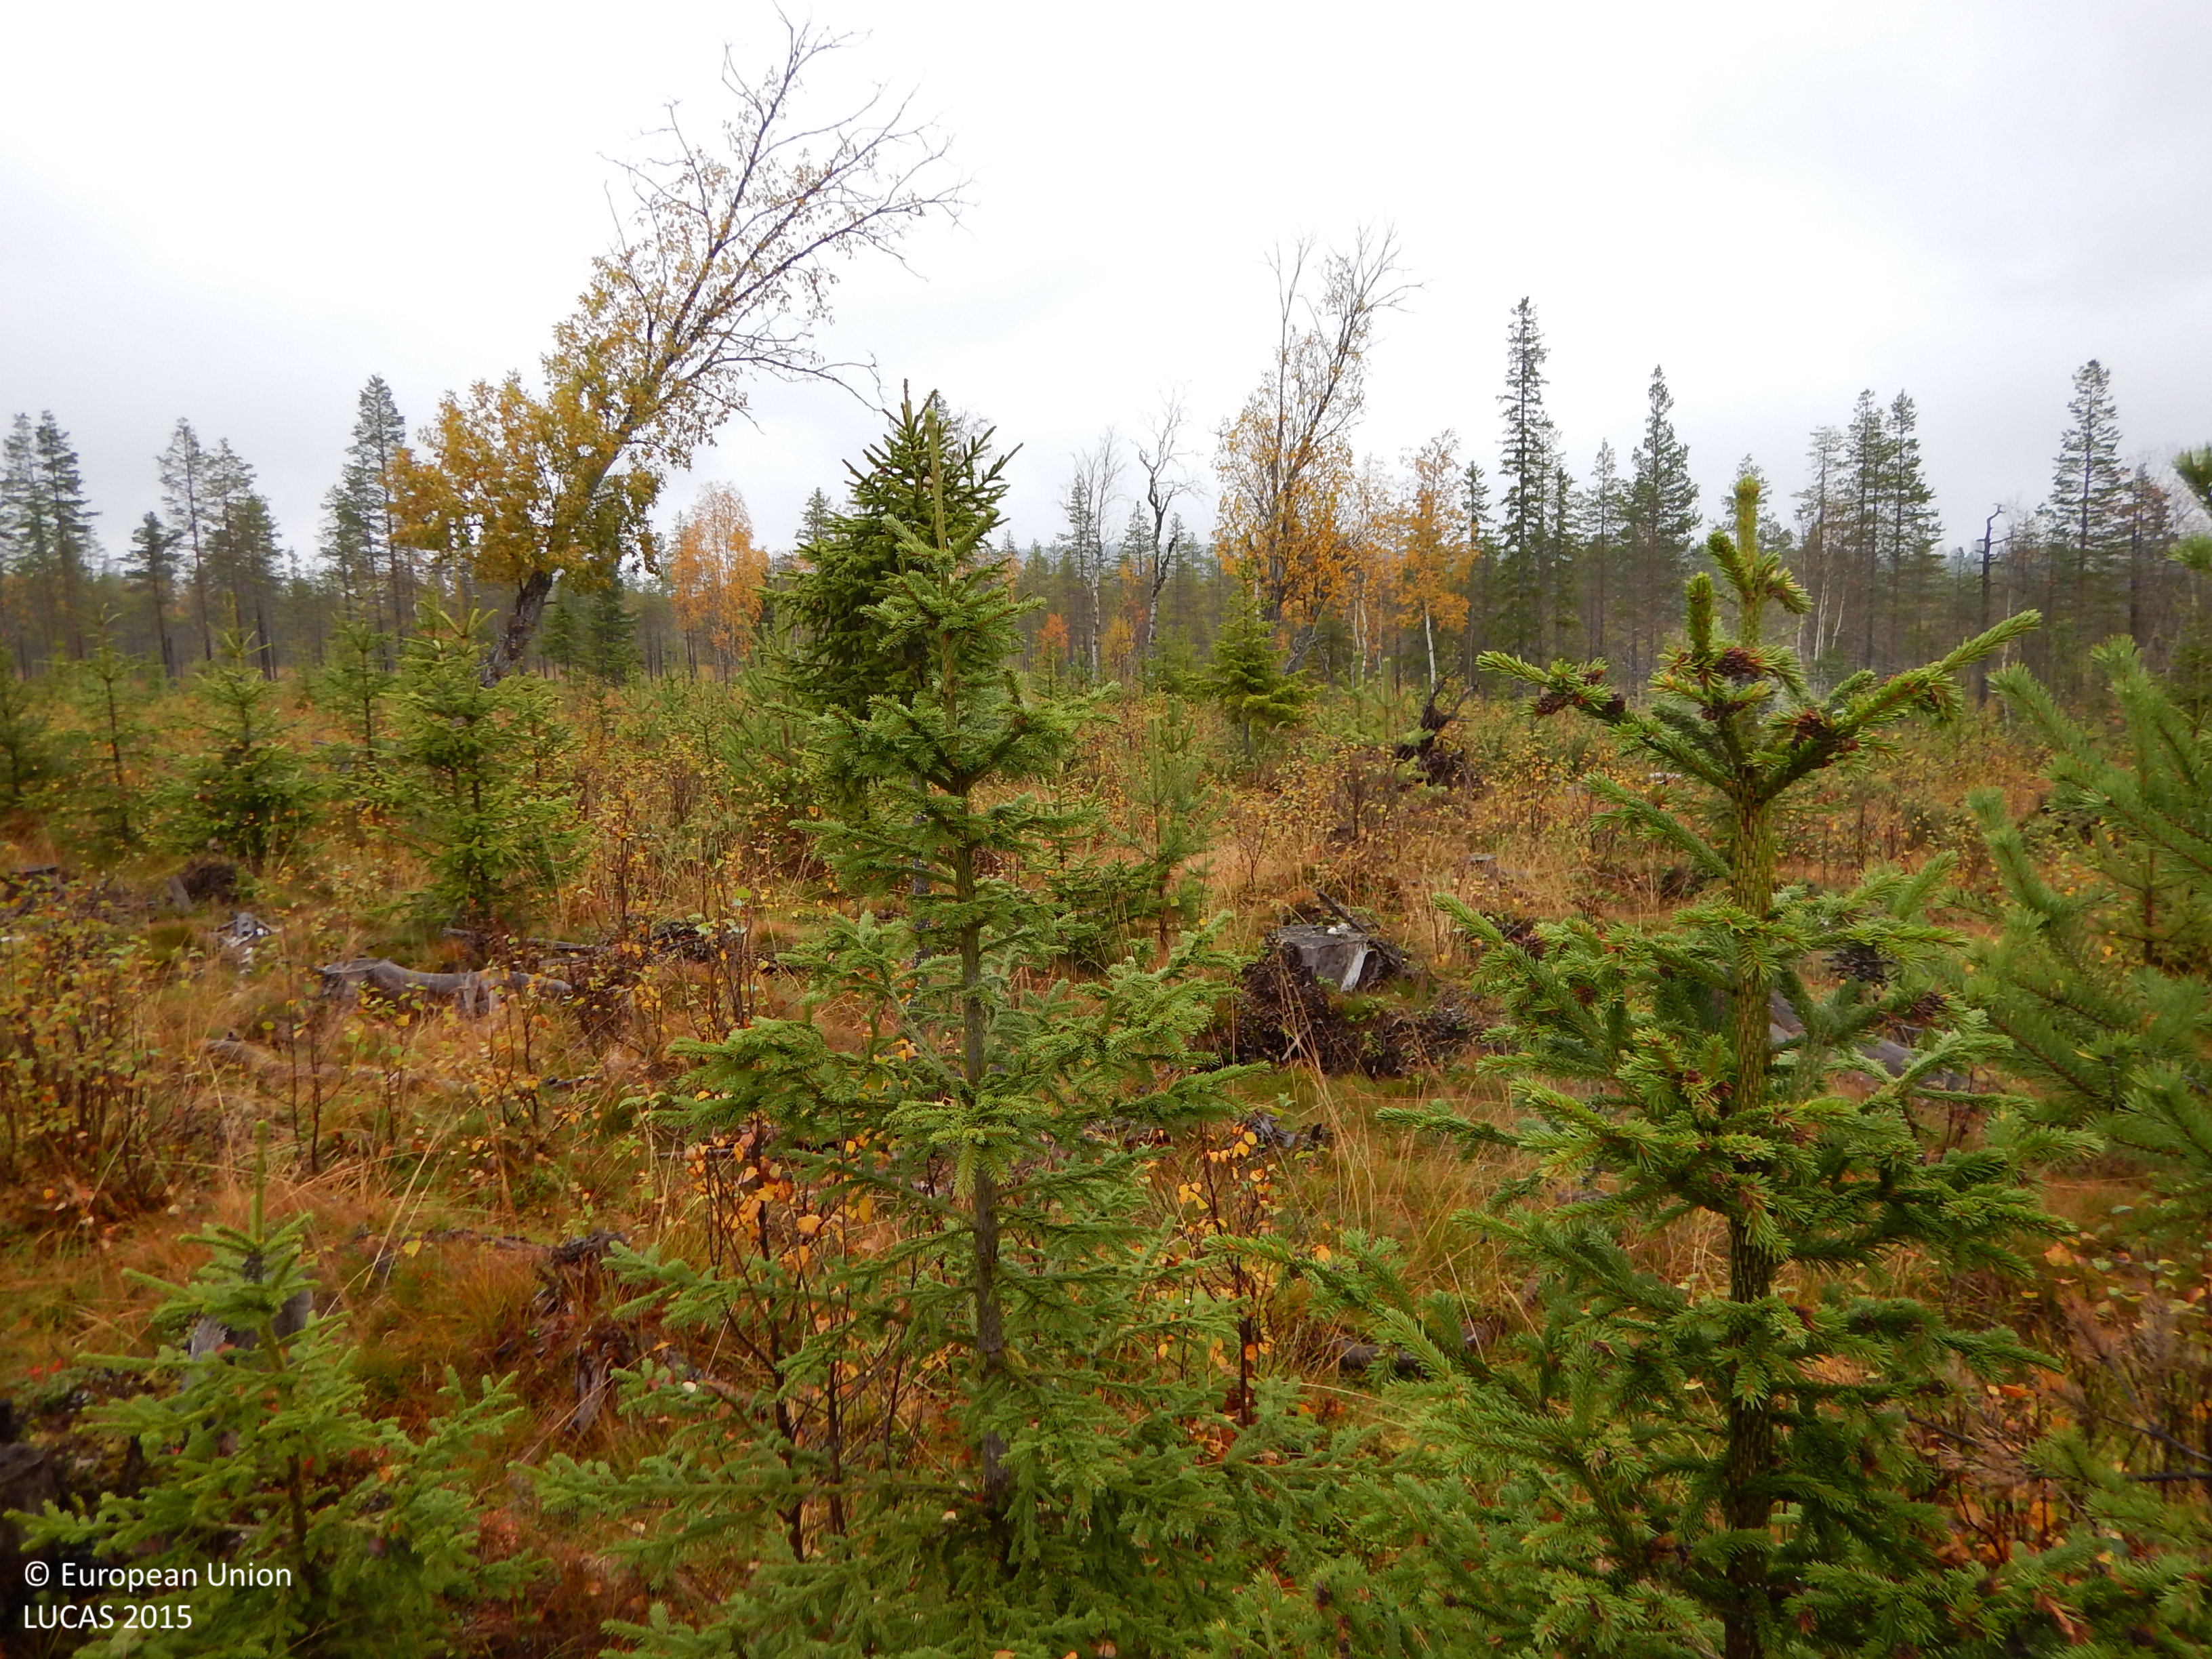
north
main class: Woodland
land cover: Other mixed woodland
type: boreal forest
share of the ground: 50 - 75 %
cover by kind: coniferous forest trees 35 %, broadleaved forest trees 20 %, lichens and mosses 20 %, herbaceous plants 15 %, shrubs 10 %
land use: Forestry
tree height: < 5 m
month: September
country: SE
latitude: 65.0385
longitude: 19.2465
